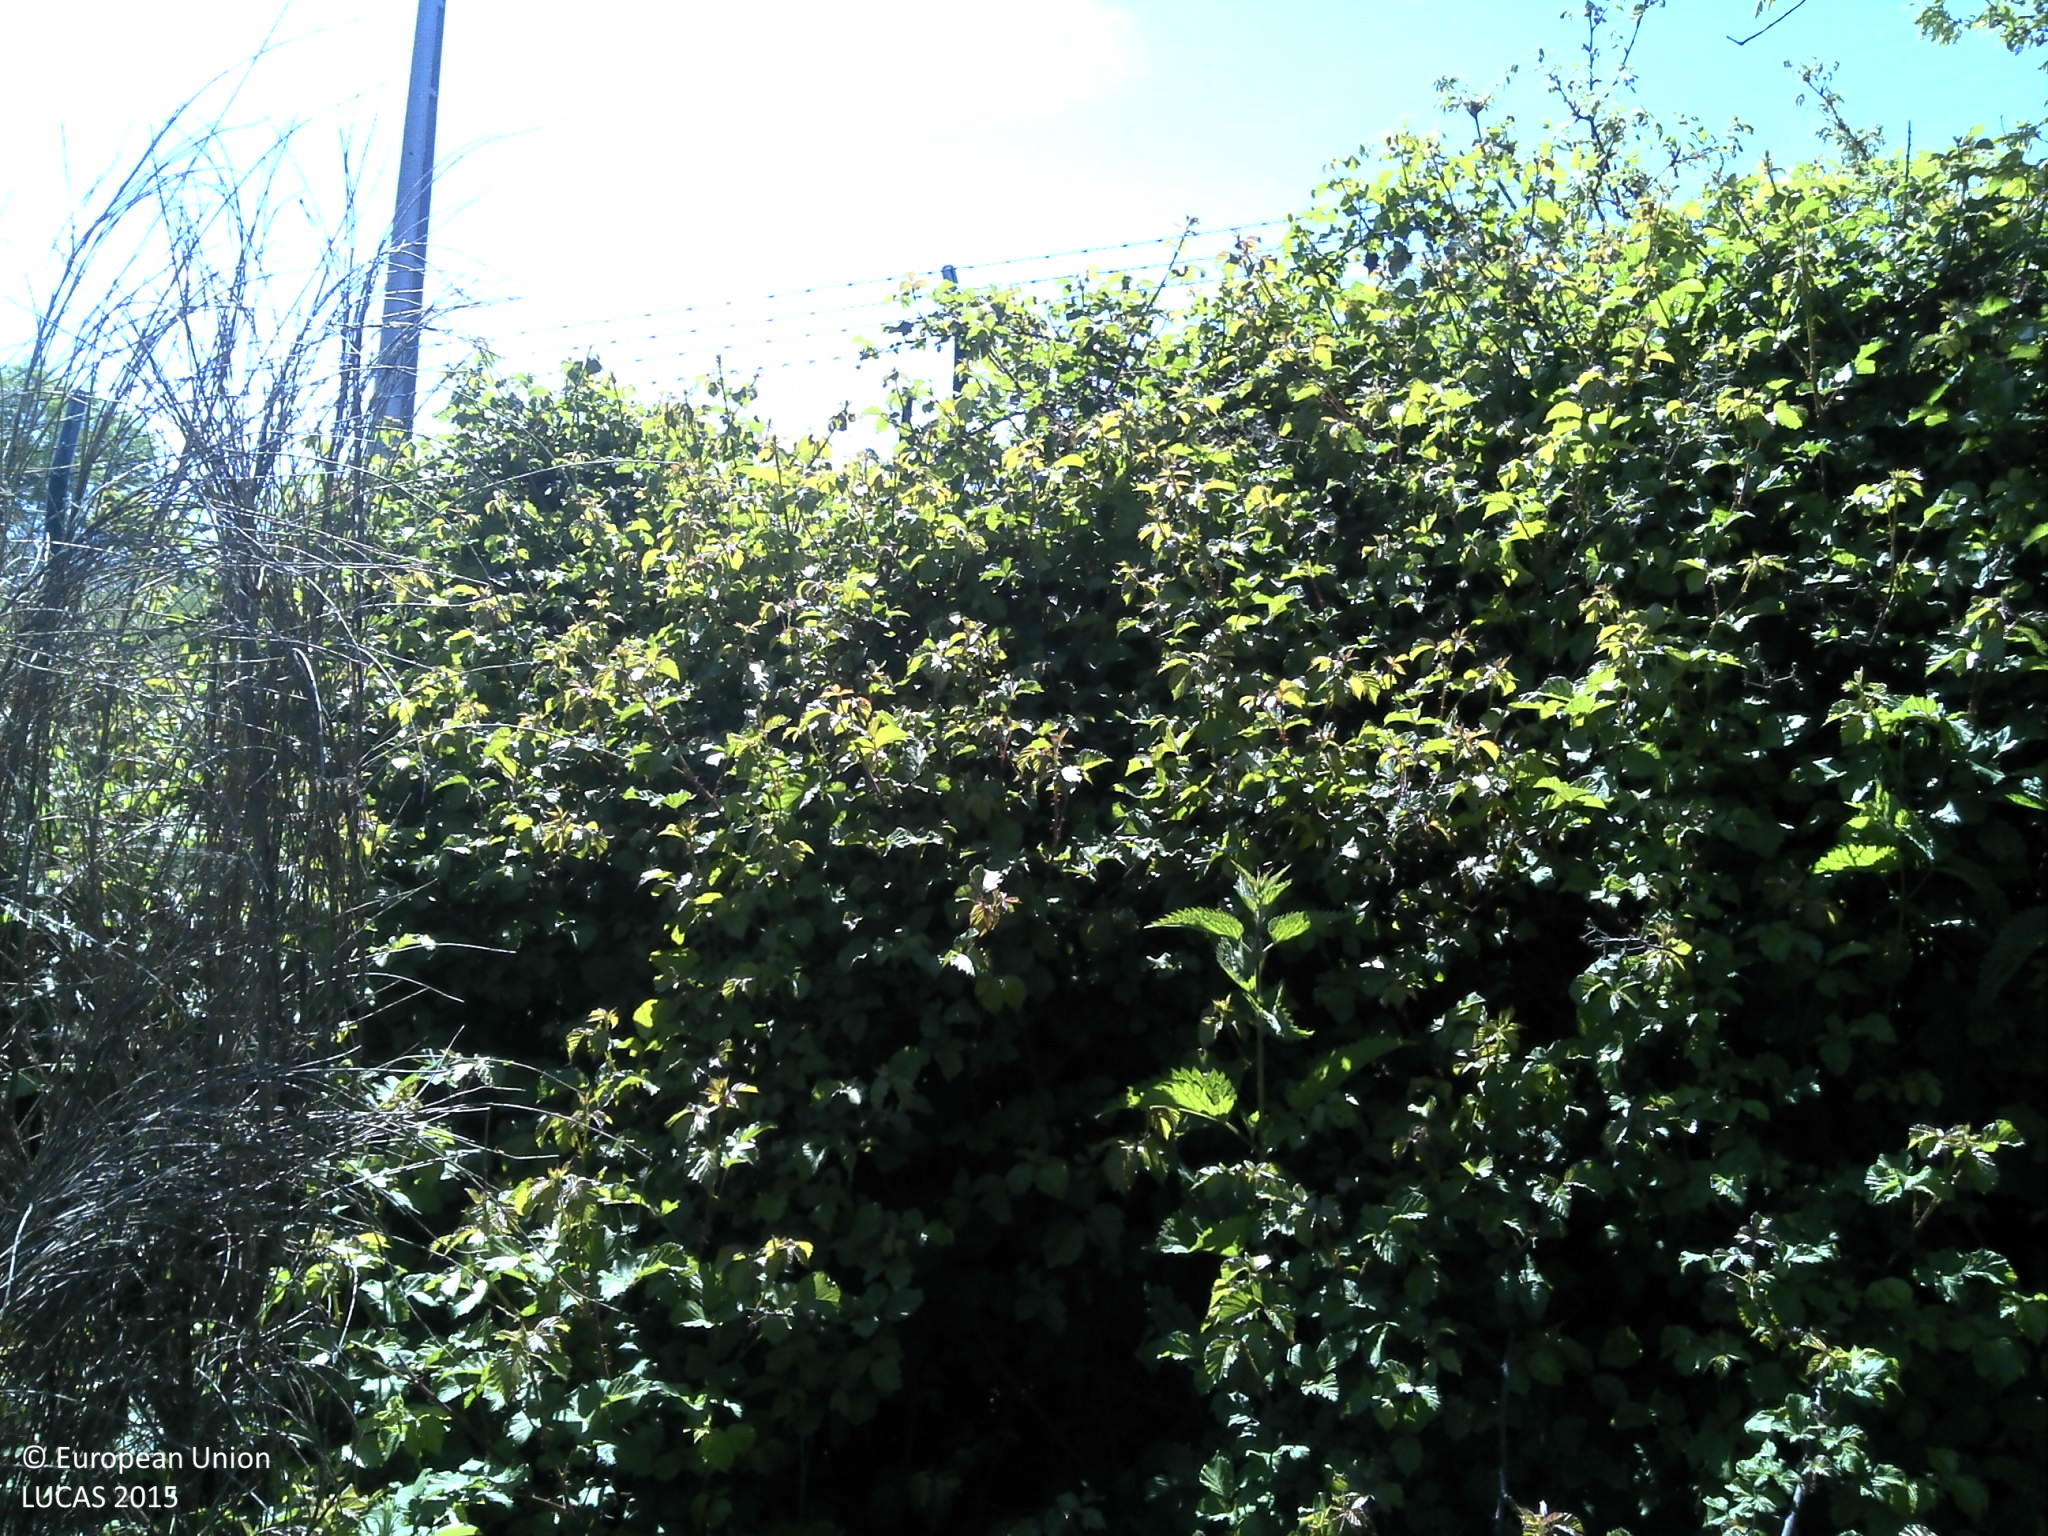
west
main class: Grassland
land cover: Grassland with sparse tree/shrub cover
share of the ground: > 75 %
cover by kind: herbaceous plants 80 %, shrubs 10 %, broadleaved forest trees 5 %, unconsolidated bare surface 5 %
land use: Agriculture (excluding fallow land and kitchen gardens)
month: May
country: PT
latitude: 41.0062
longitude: -7.9050
